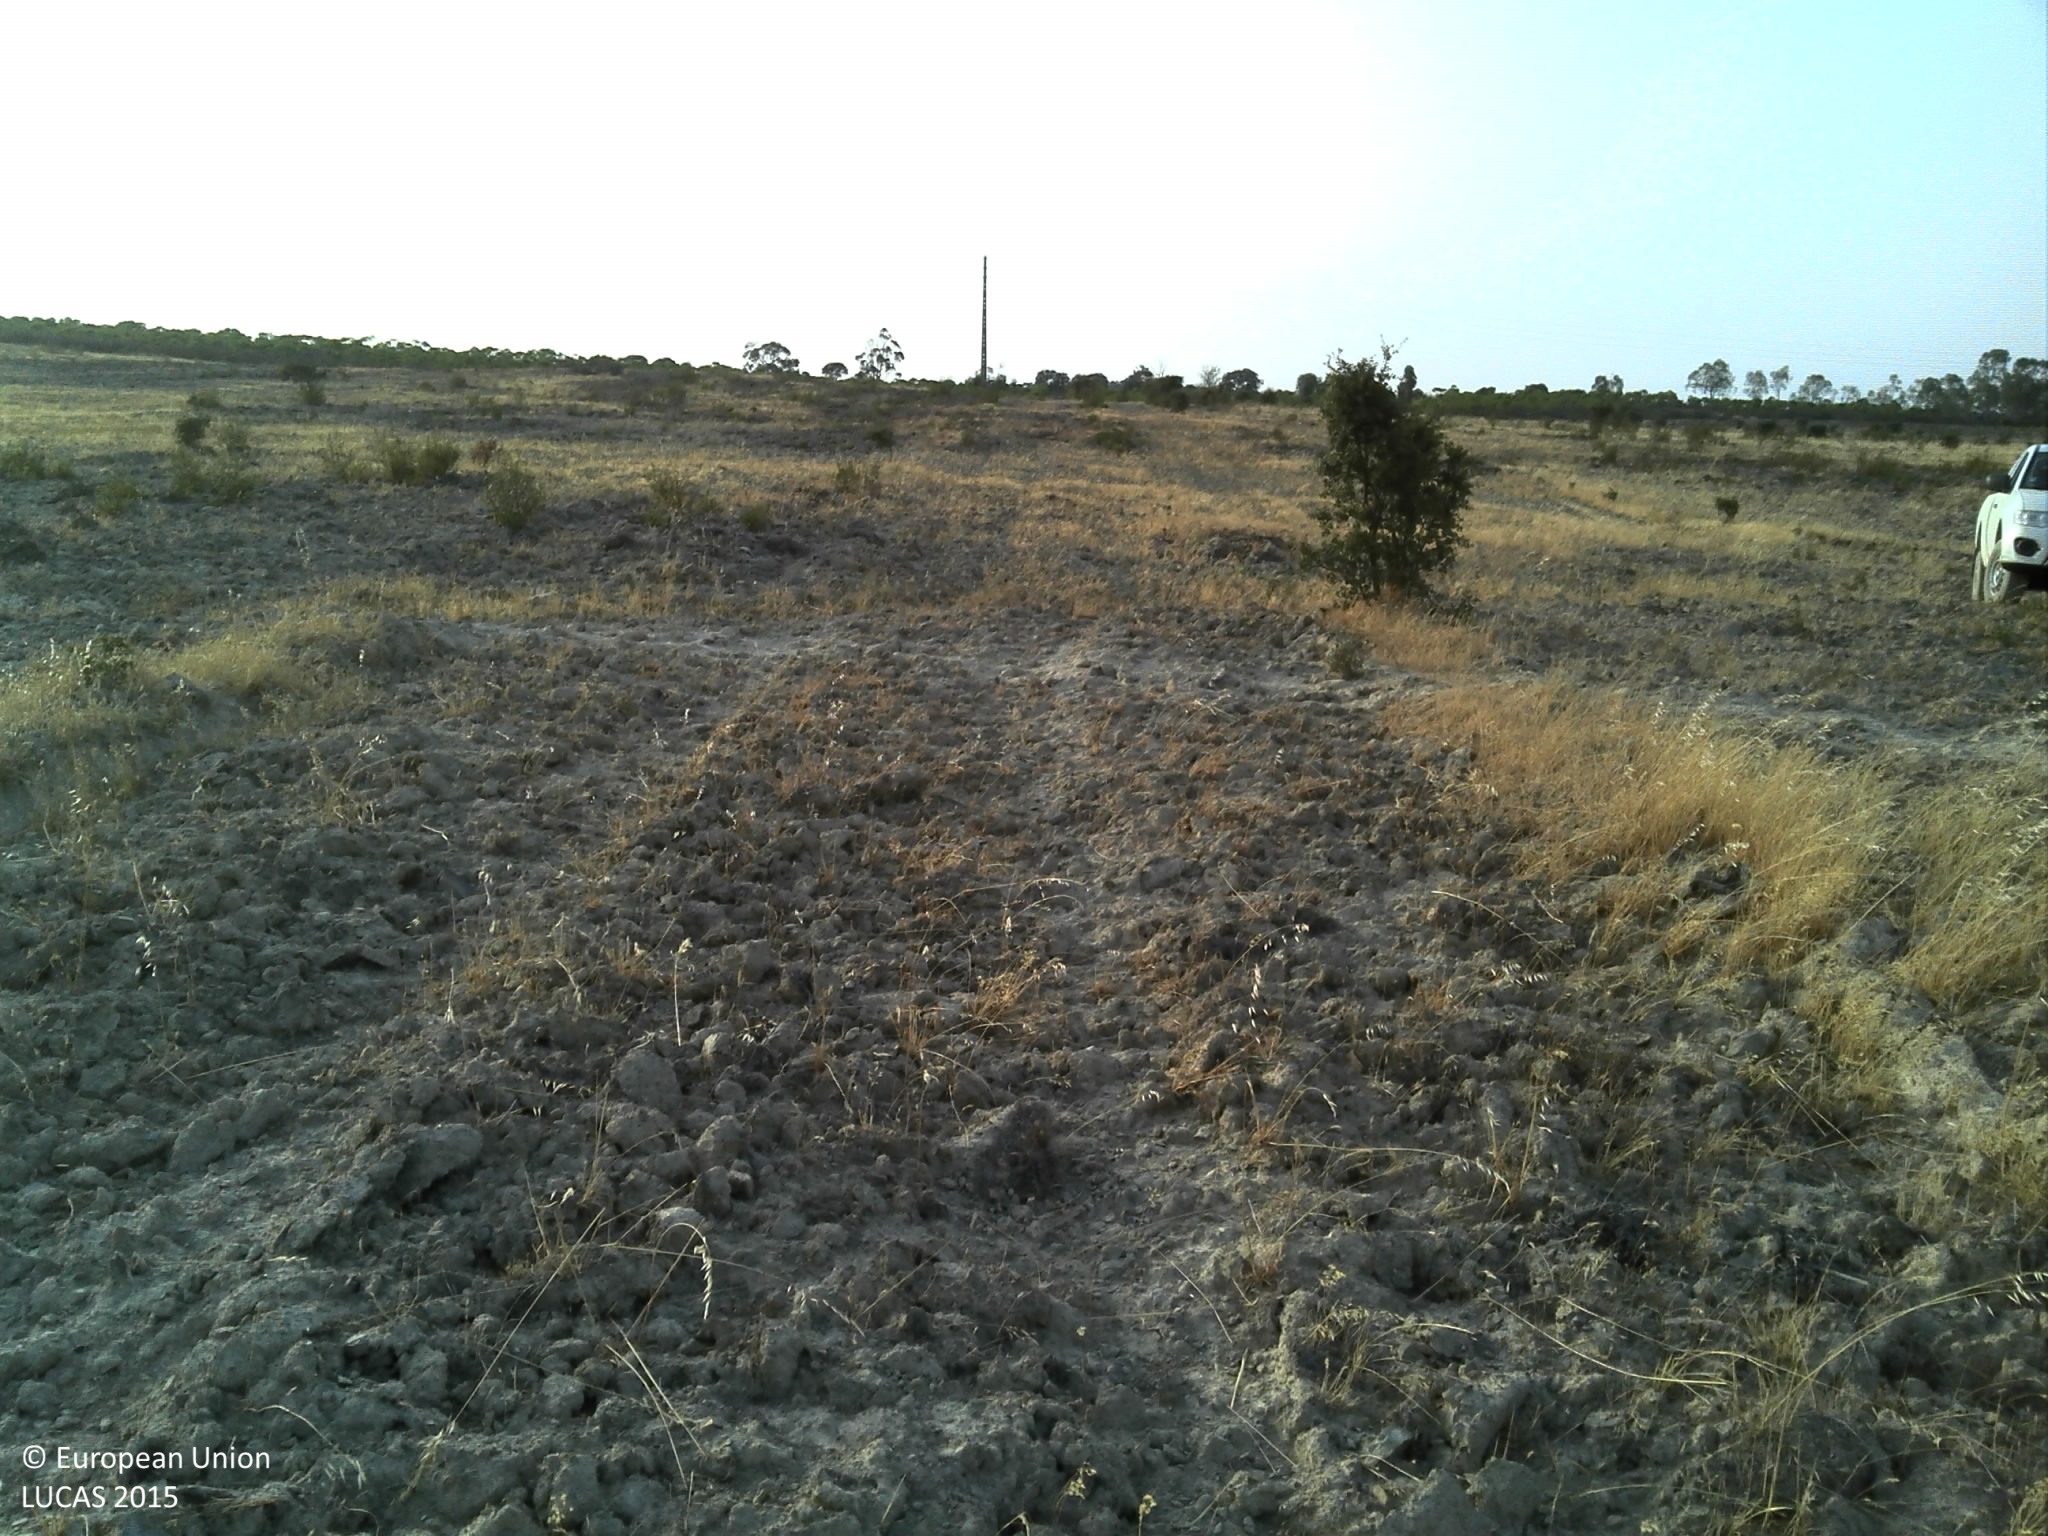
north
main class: Grassland
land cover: Grassland with sparse tree/shrub cover
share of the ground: 50 - 75 %
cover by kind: unconsolidated bare surface 80 %, herbaceous plants 15 %, broadleaved forest trees 5 %
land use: Forestry
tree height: < 5 m
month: July
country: PT
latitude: 37.5491
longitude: -7.9147
